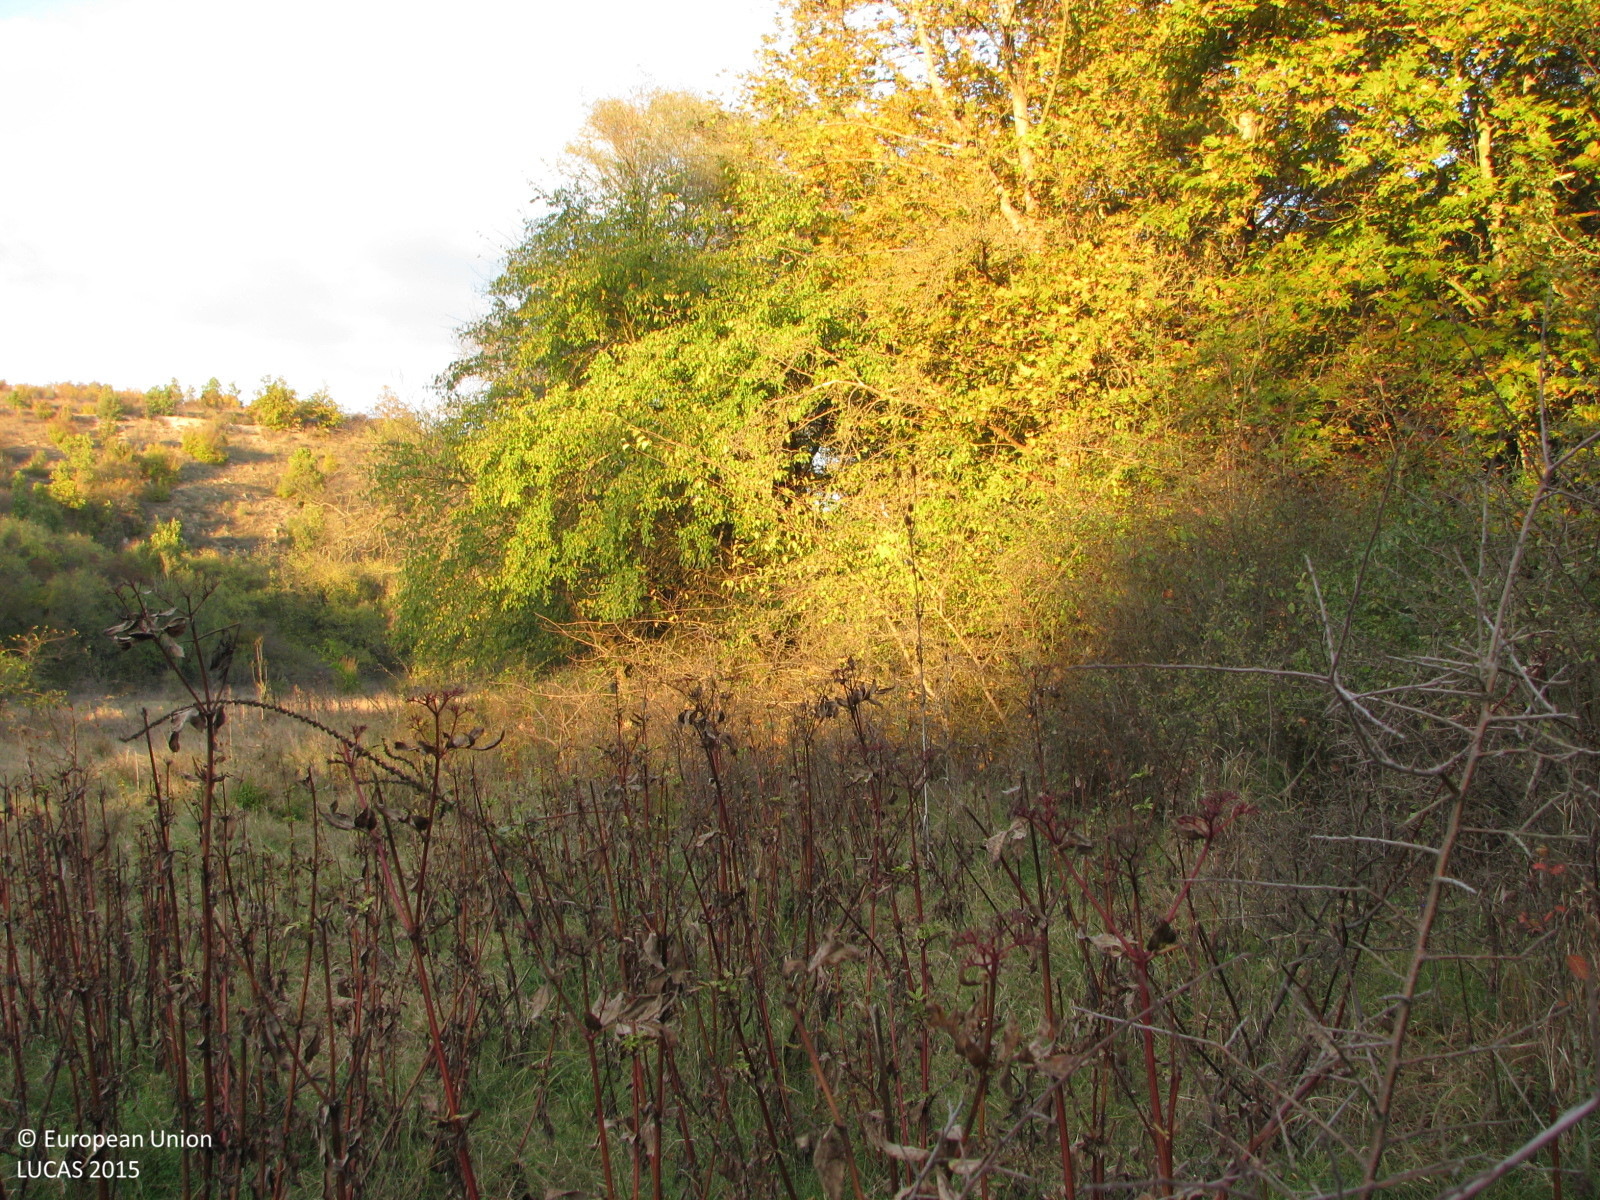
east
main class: Grassland
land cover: Grassland with sparse tree/shrub cover
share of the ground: > 75 %
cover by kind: herbaceous plants 90 %, broadleaved forest trees 5 %, shrubs 5 %
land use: Semi-natural and natural areas not in use
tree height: > 5 m
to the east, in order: Grassland with sparse tree/shrub cover; Broadleaved woodland; Inland fresh running water; Broadleaved woodland; Shrubland with sparse tree cover
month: October
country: BG
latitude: 42.1293
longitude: 26.4293
